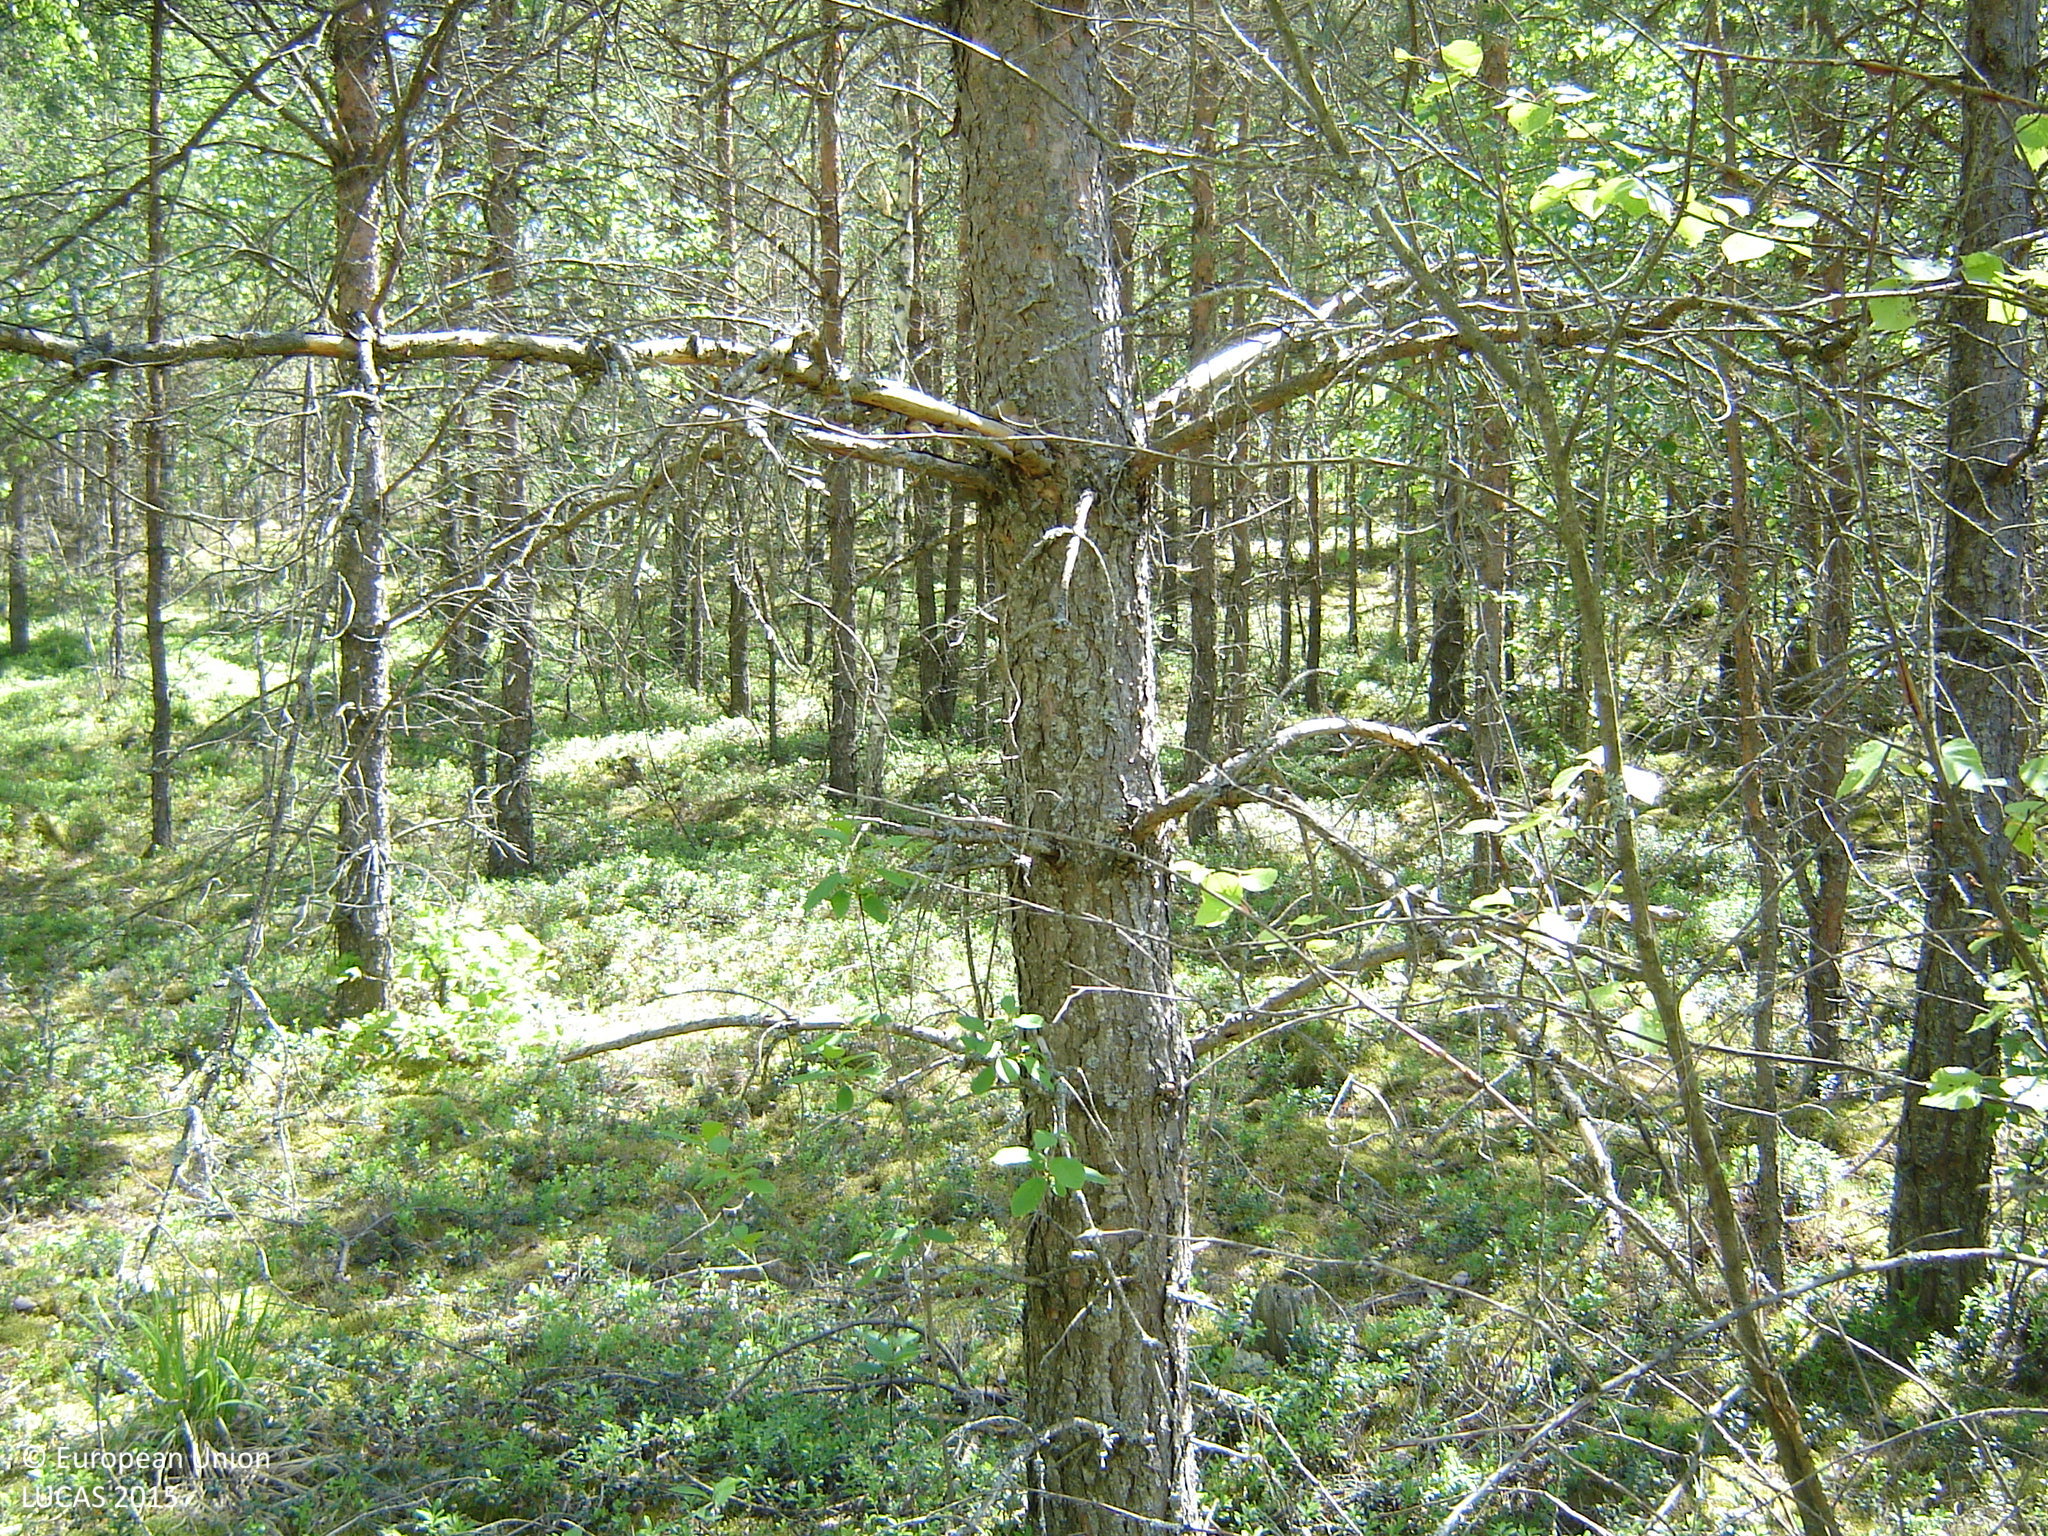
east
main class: Woodland
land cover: Pine dominated coniferous woodland
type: hemiboreal forest and nemoral coniferous forest and mixed broadleaved-coniferous forest
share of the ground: > 75 %
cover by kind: coniferous forest trees 75 %, shrubs 10 %, lichens and mosses 10 %, broadleaved forest trees 5 %
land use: Forestry
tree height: > 5 m
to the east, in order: Pine dominated coniferous woodland; Spruce dominated coniferous woodland; Broadleaved woodland; Grass margins; Paved roads, cycling and walking lanes; Grass margins; Broadleaved woodland; Ditches and canals; Broadleaved woodland; Grassland without tree/shrub cover
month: June
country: LT
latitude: 55.6357
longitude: 25.0936
